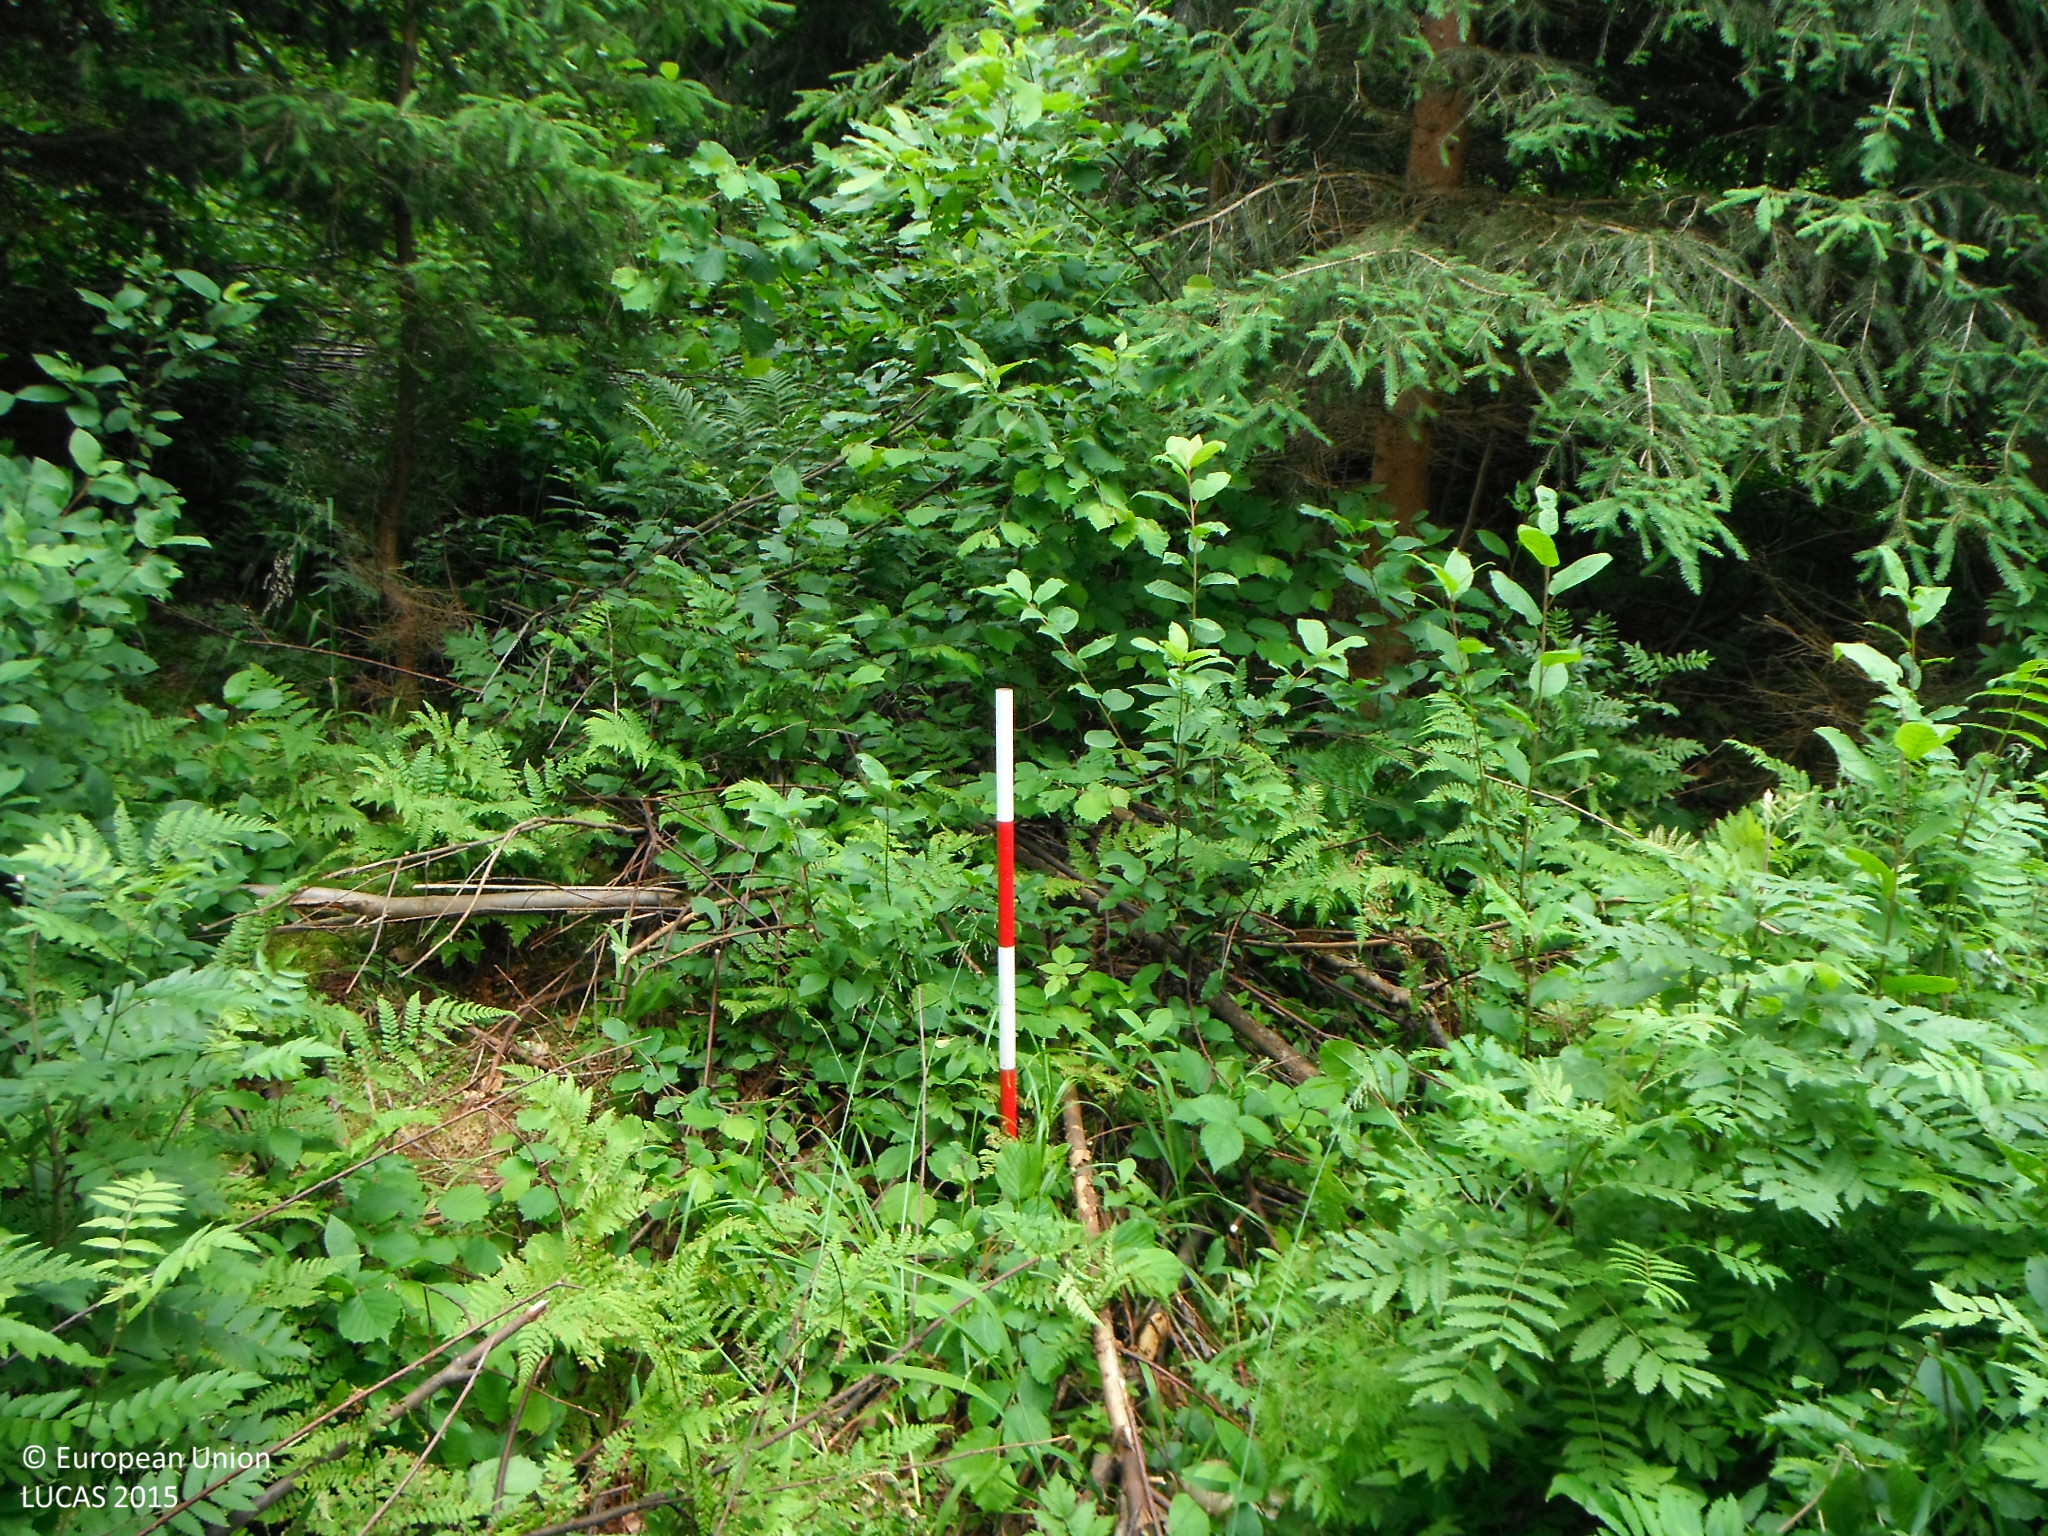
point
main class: Woodland
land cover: Spruce dominated coniferous woodland
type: hemiboreal forest and nemoral coniferous forest and mixed broadleaved-coniferous forest
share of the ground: 50 - 75 %
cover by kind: coniferous forest trees 65 %, shrubs 15 %, herbaceous plants 15 %, broadleaved forest trees 5 %
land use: Forestry
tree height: > 5 m
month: June
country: SK
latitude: 49.2000
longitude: 19.3712
